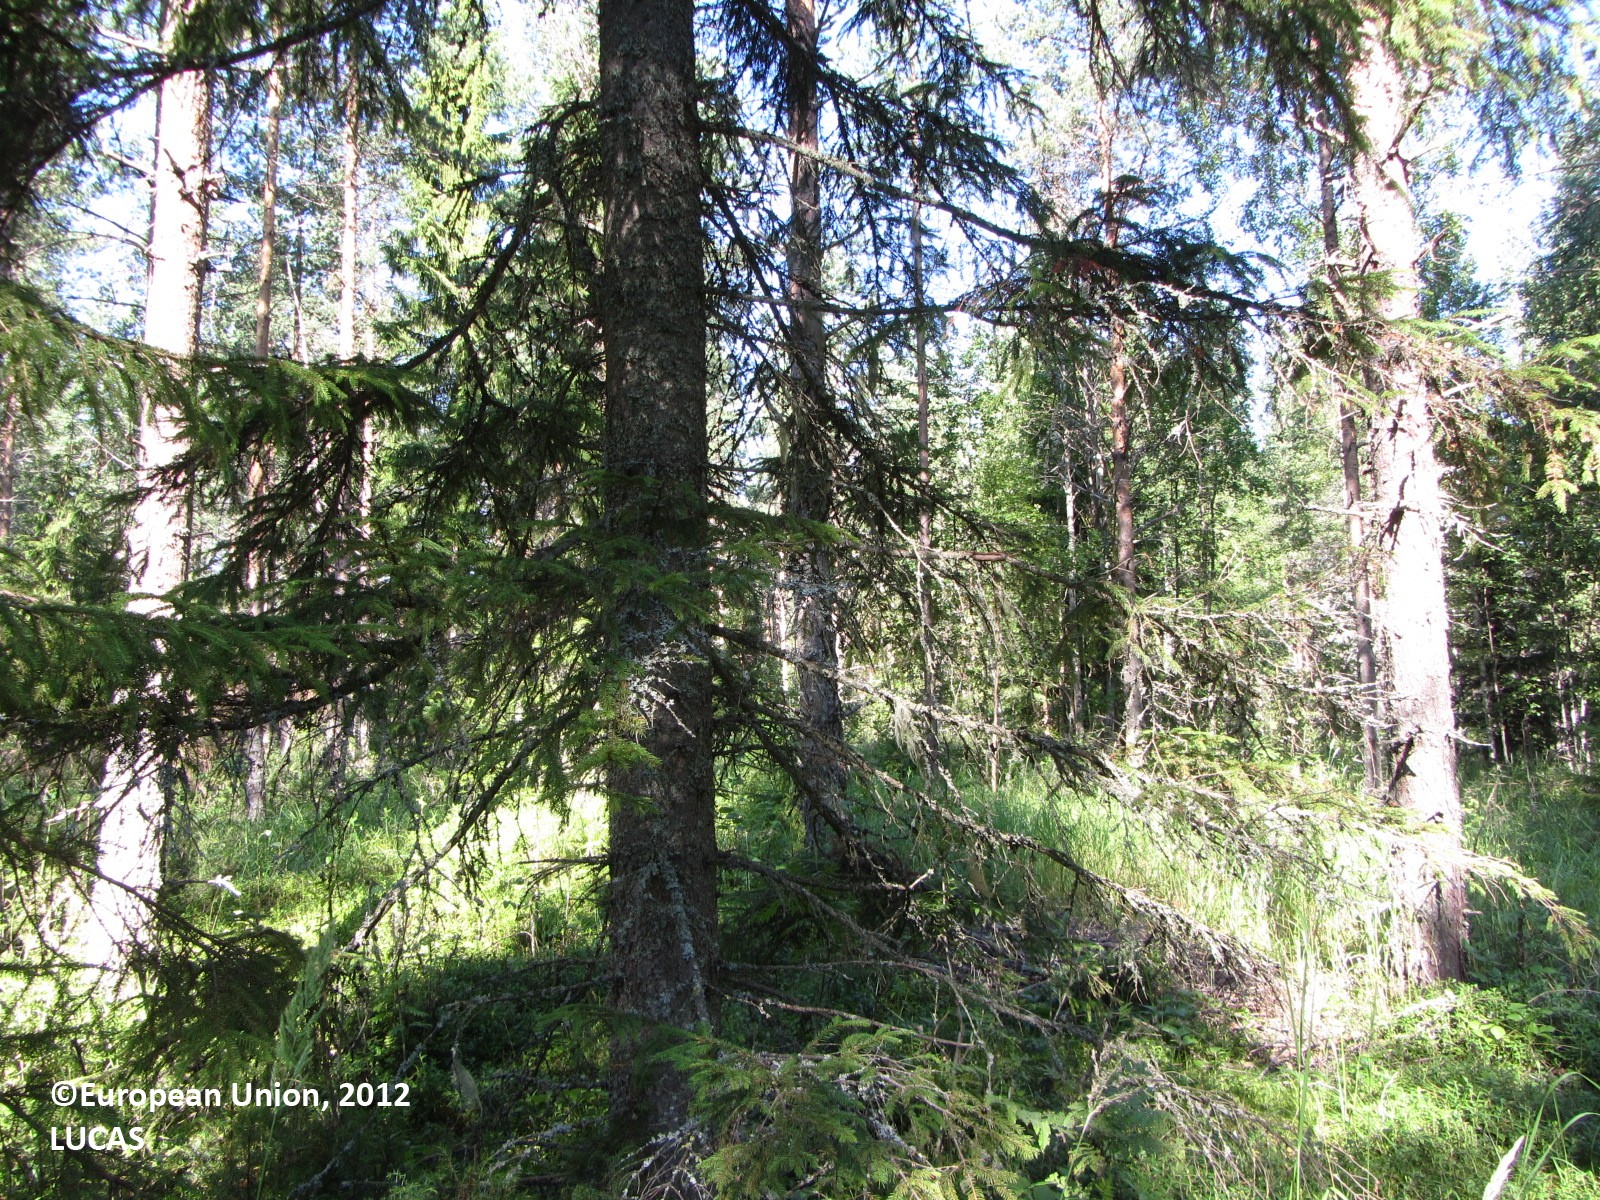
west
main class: Woodland
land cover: Pine dominated coniferous woodland
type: boreal forest
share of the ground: 50 - 75 %
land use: Forestry
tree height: > 5 m
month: July
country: FI
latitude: 63.6370
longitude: 24.6754
